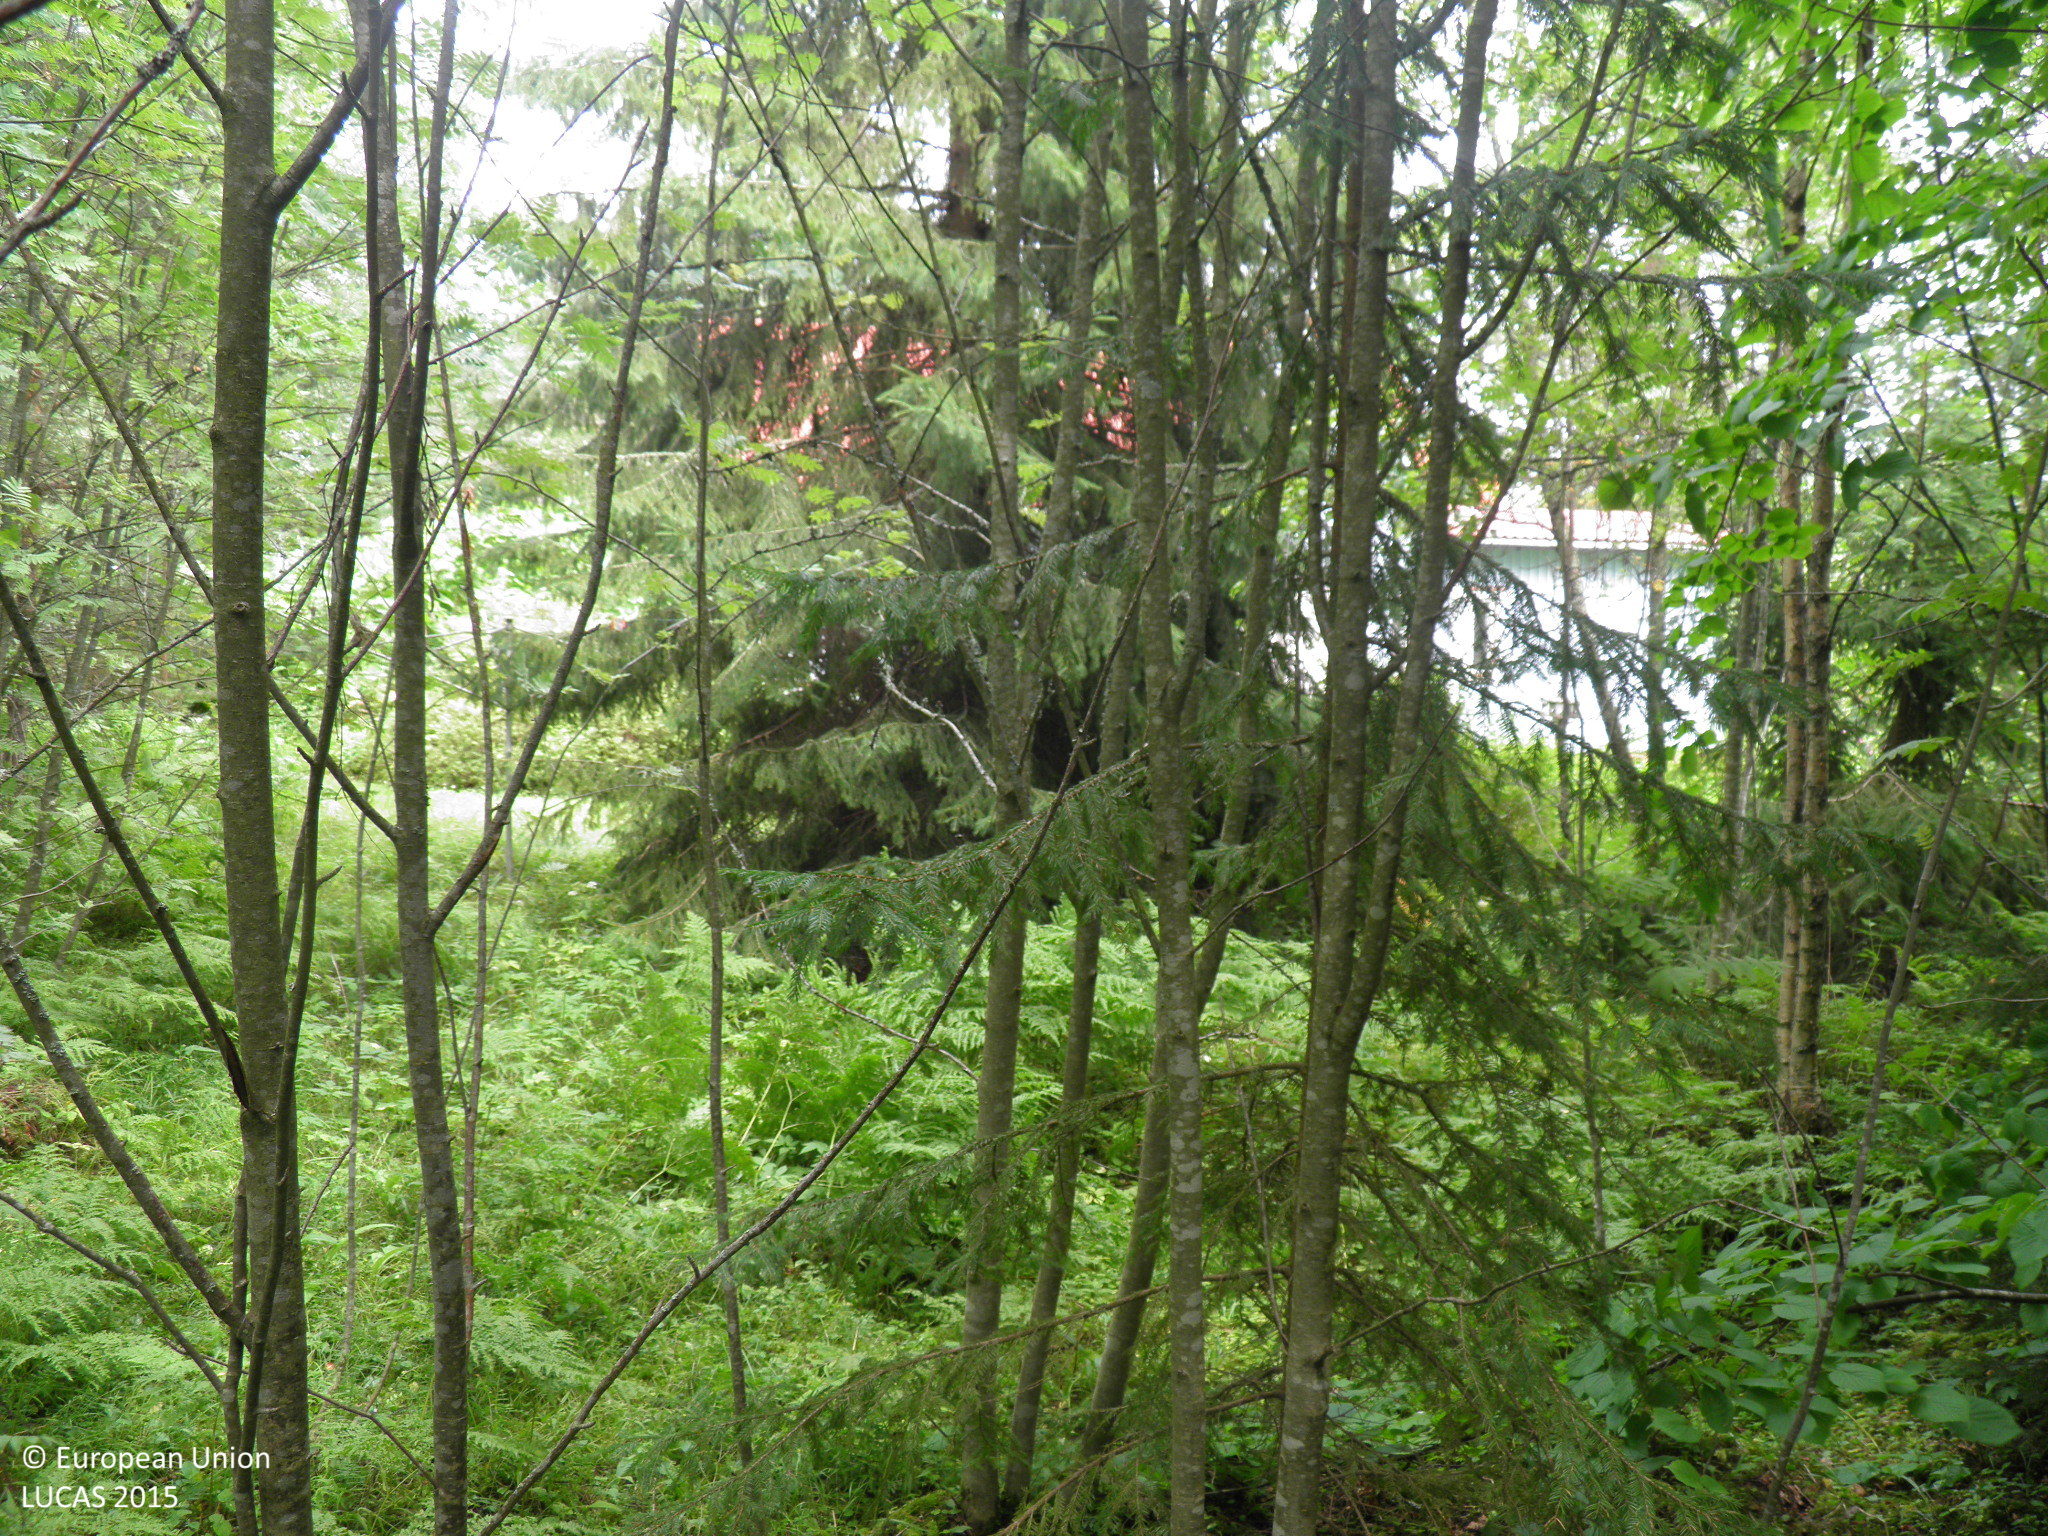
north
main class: Woodland
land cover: Pine dominated mixed woodland
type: hemiboreal forest and nemoral coniferous forest and mixed broadleaved-coniferous forest
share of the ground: > 75 %
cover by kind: broadleaved forest trees 60 %, coniferous forest trees 20 %, shrubs 10 %, herbaceous plants 10 %
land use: Residential
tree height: > 5 m
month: July
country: FI
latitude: 60.0646
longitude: 22.4502
